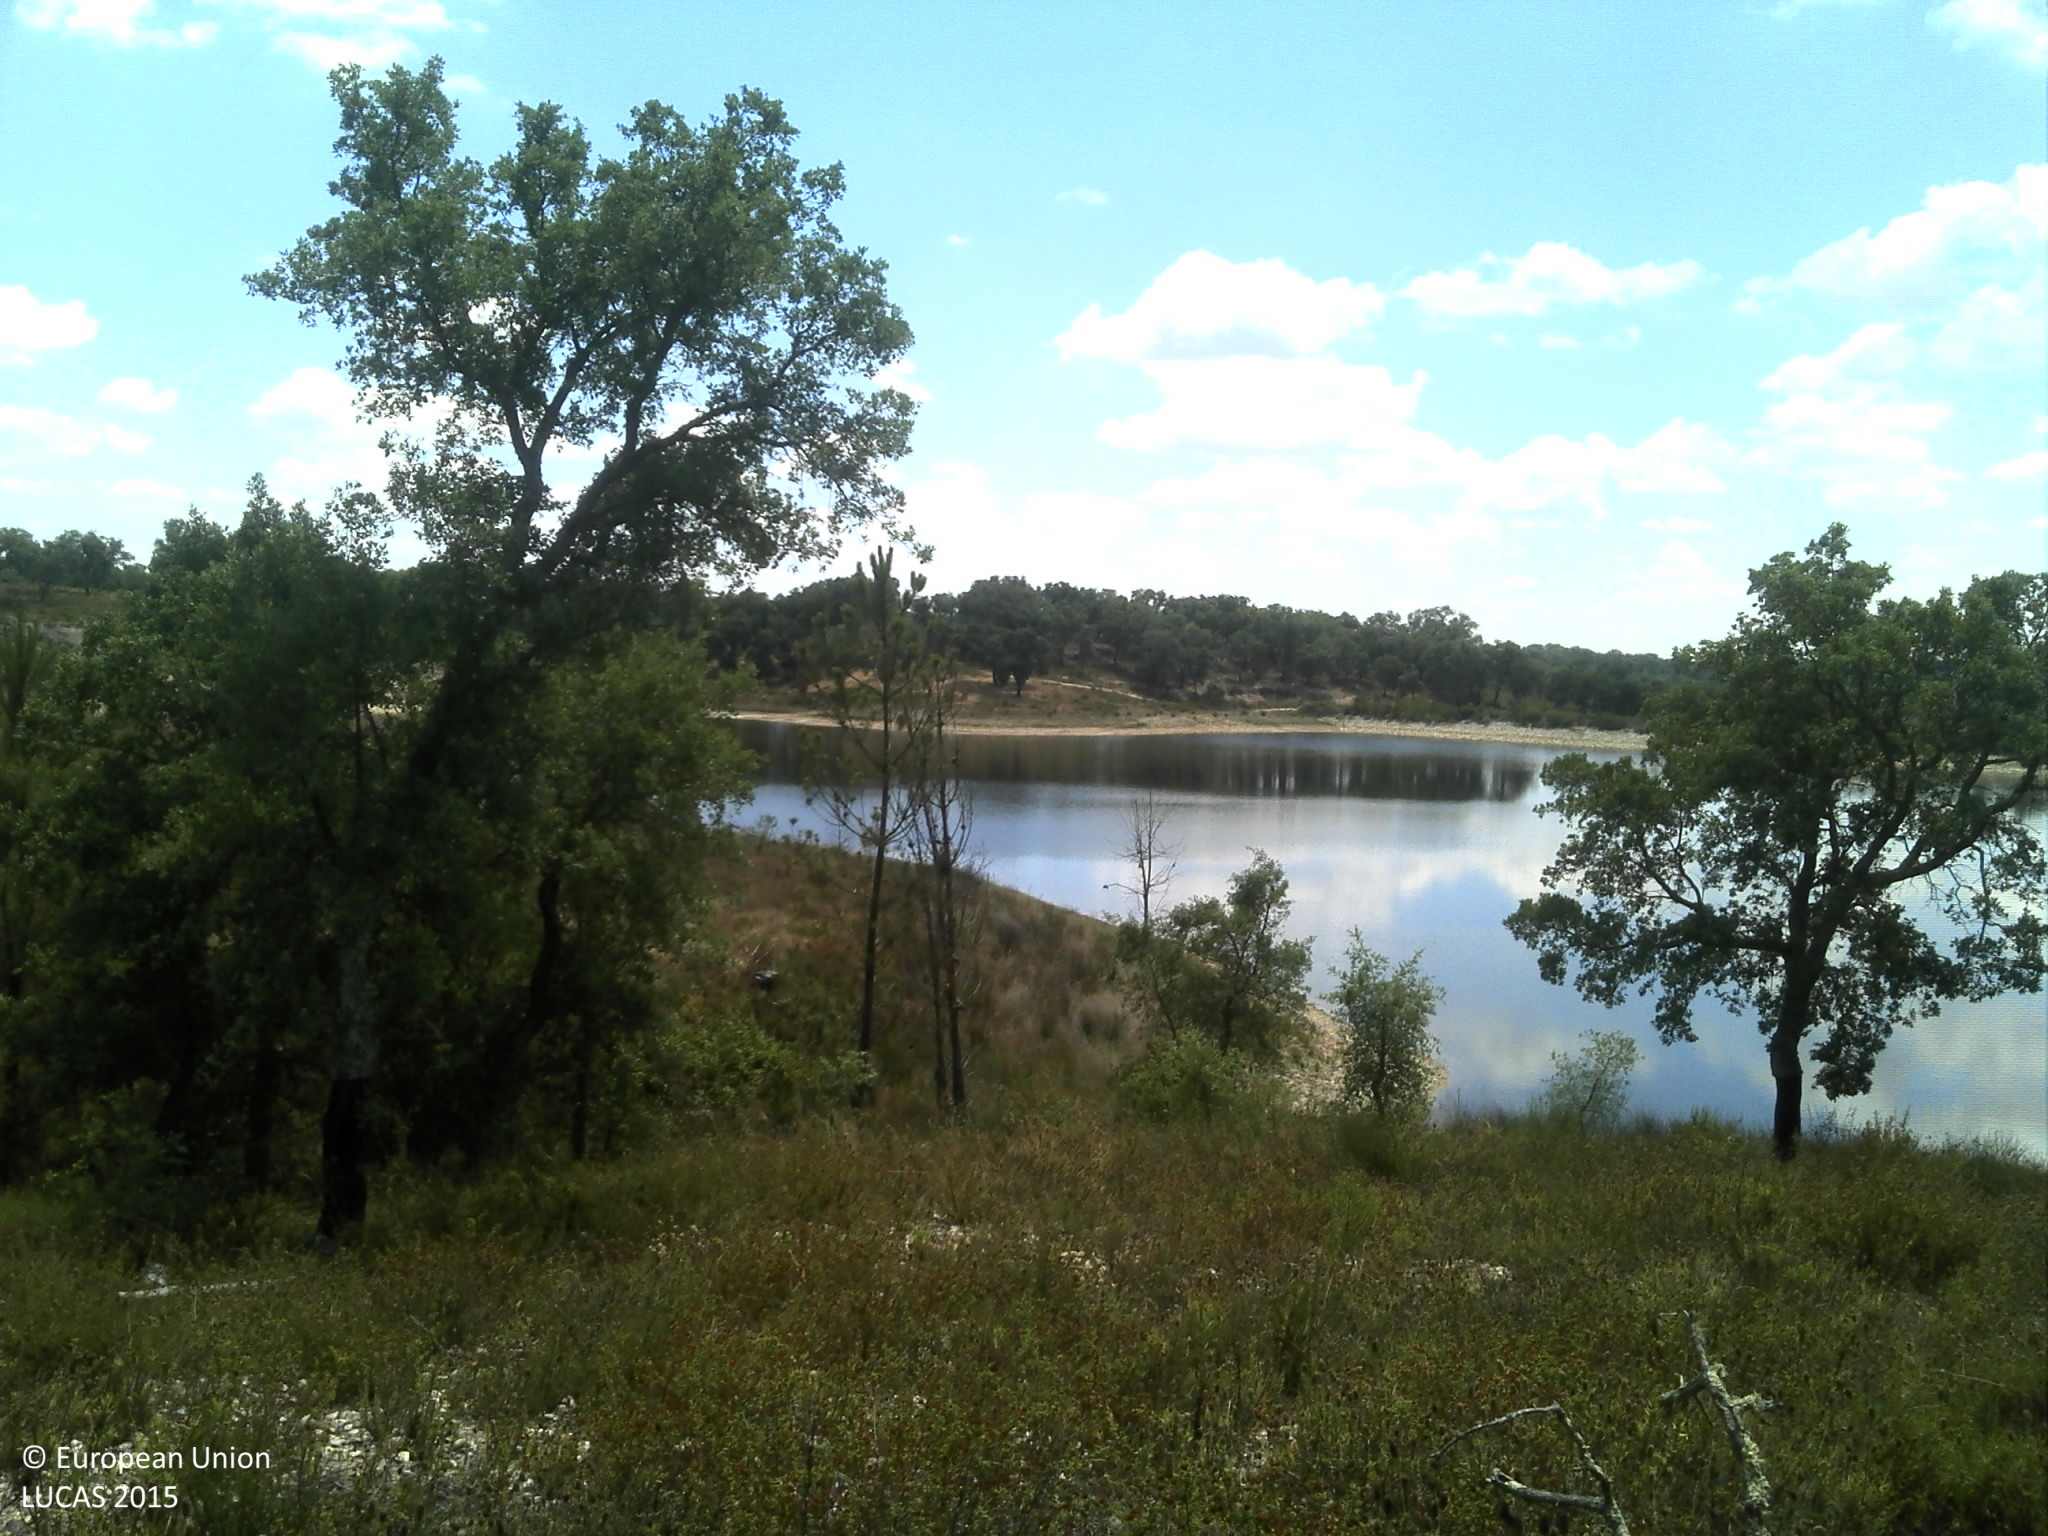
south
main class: Woodland
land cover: Broadleaved woodland
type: broadleaved evergreen forest
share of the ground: 10 - 25 %
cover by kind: unconsolidated bare surface 40 %, broadleaved forest trees 25 %, shrubs 25 %, herbaceous plants 10 %
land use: Forestry
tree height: > 5 m
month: June
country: PT
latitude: 39.2745
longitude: -8.2726
